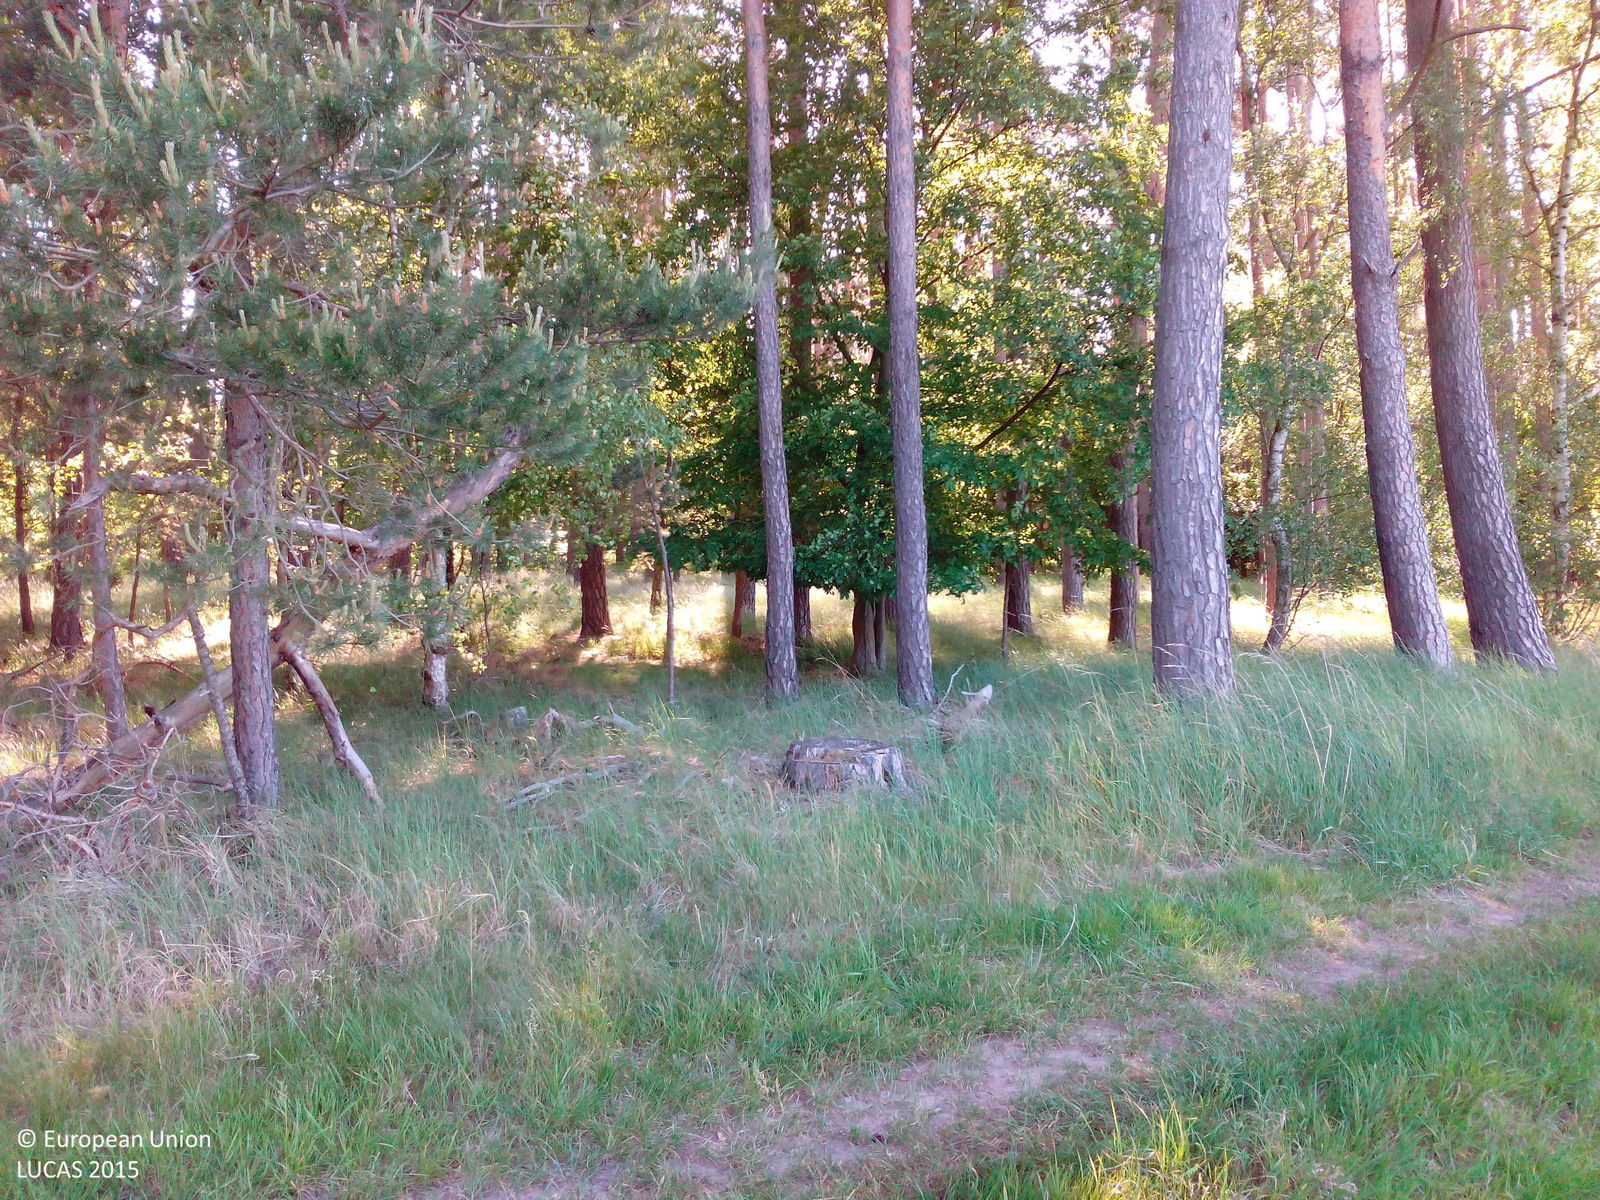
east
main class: Cropland
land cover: Common wheat
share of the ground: > 75 %
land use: Agriculture (excluding fallow land and kitchen gardens)
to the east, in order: Common wheat; Tracks; Pine dominated mixed woodland; Fences; Pine dominated mixed woodland; Tracks; Pine dominated mixed woodland
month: June
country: DE
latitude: 50.8555
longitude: 11.6617
